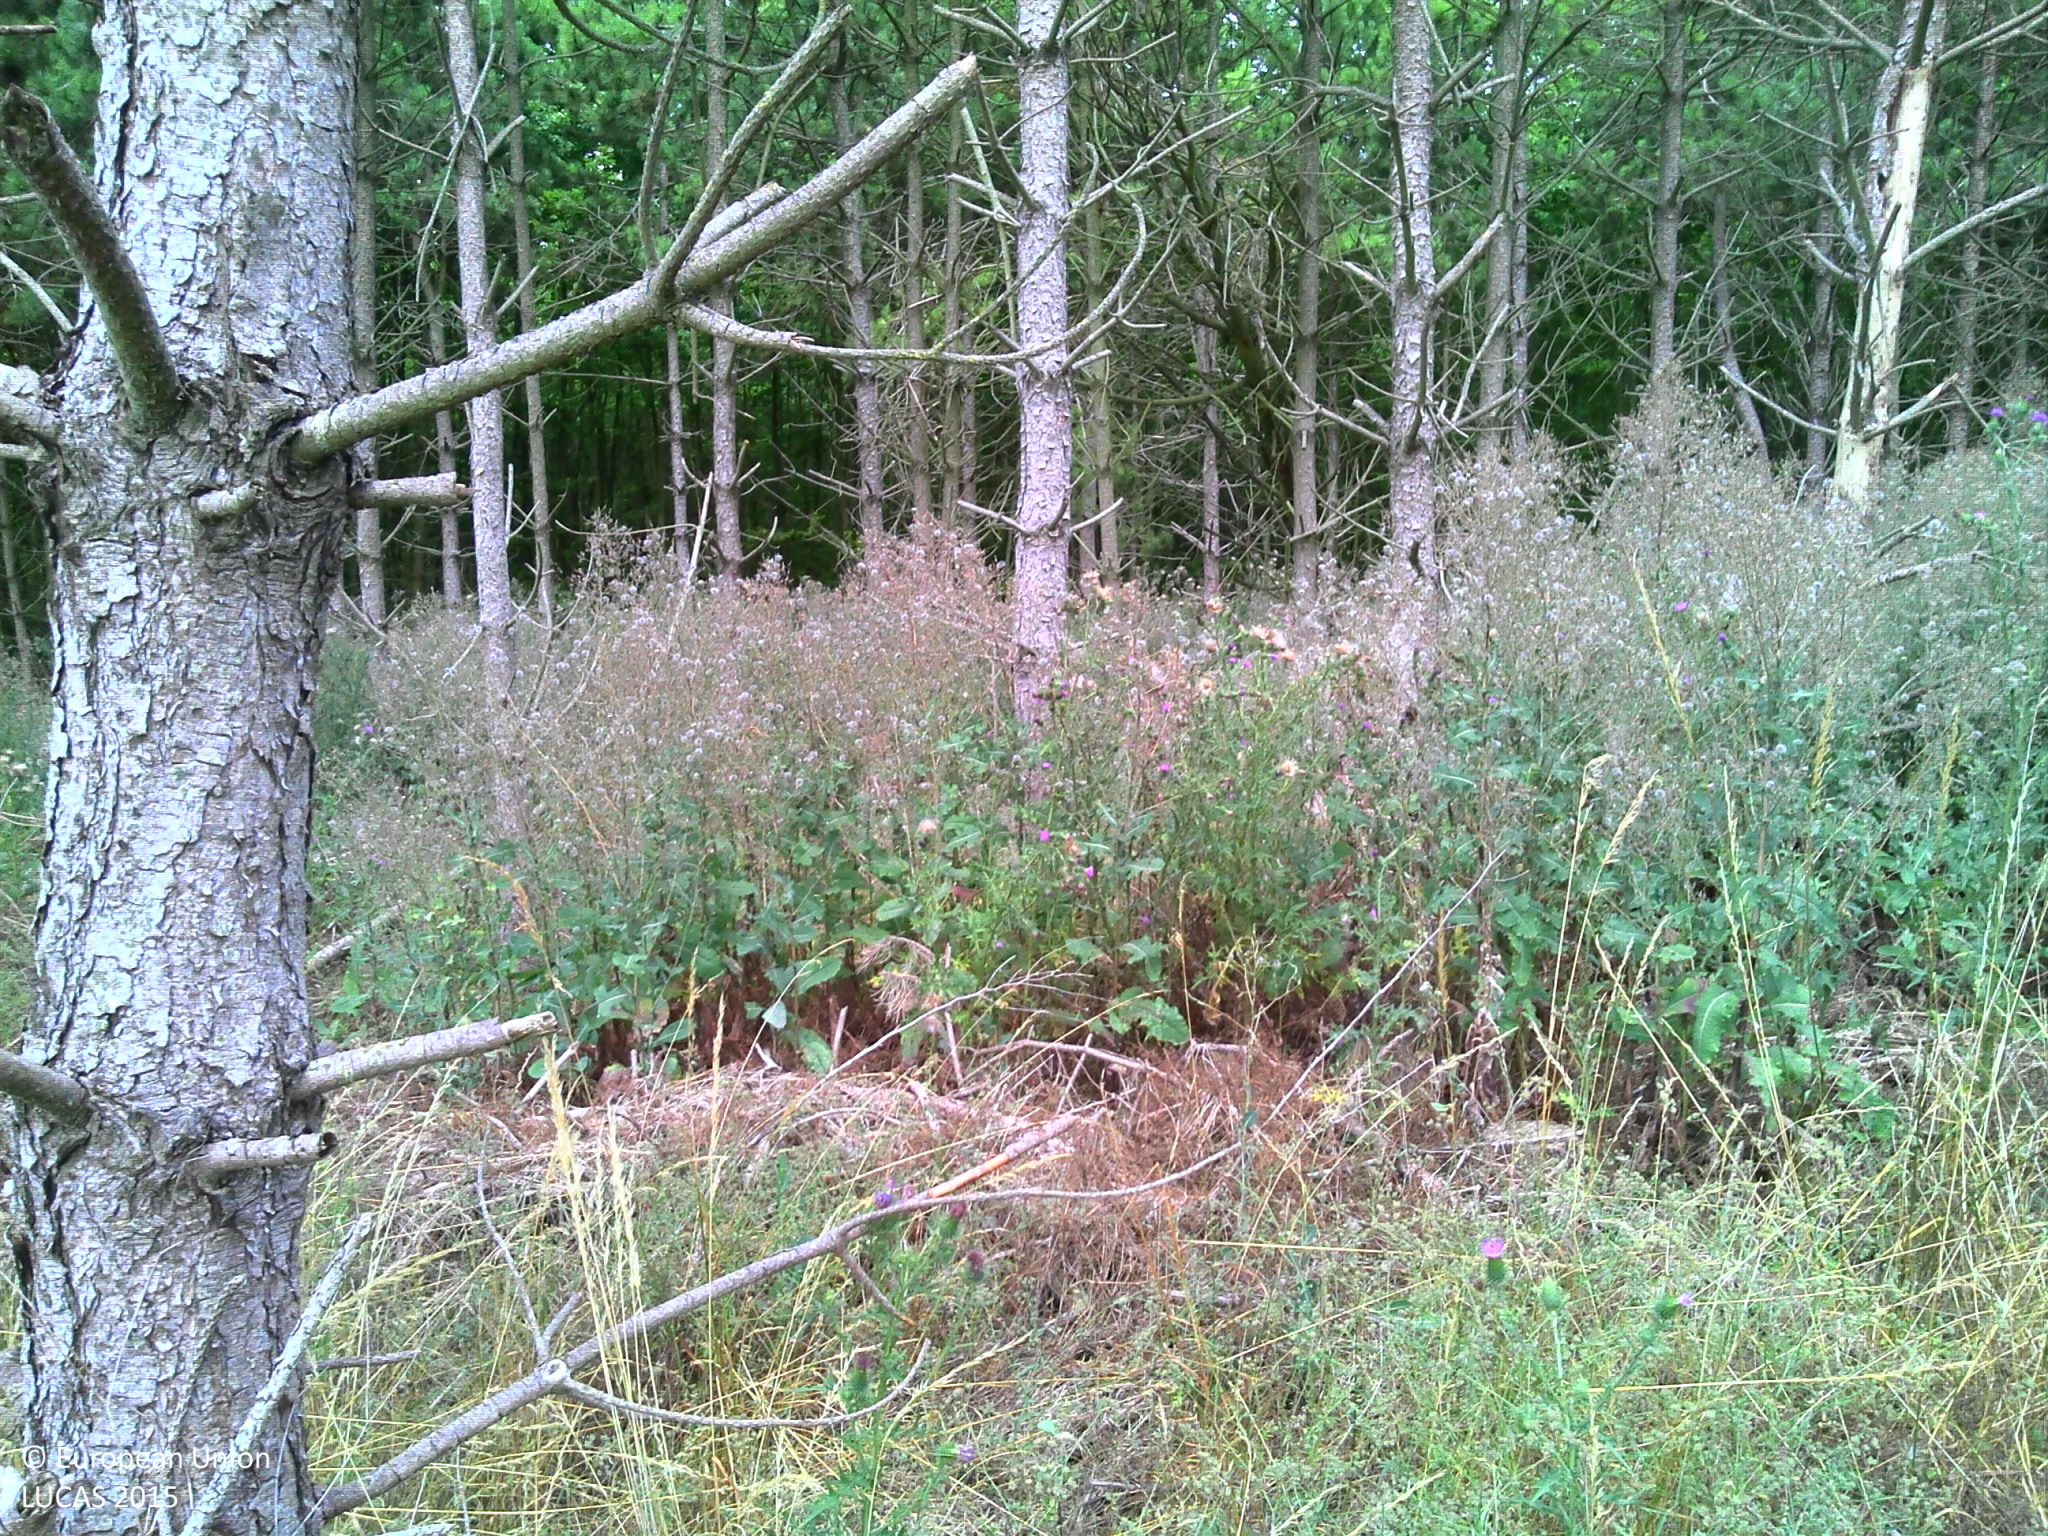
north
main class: Woodland
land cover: Pine dominated coniferous woodland
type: boreal forest
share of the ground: > 75 %
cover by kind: coniferous forest trees 60 %, herbaceous plants 30 %, lichens and mosses 5 %, unconsolidated bare surface 5 %
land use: Forestry
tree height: > 5 m
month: July
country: FR
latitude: 49.3859
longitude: 4.1681
